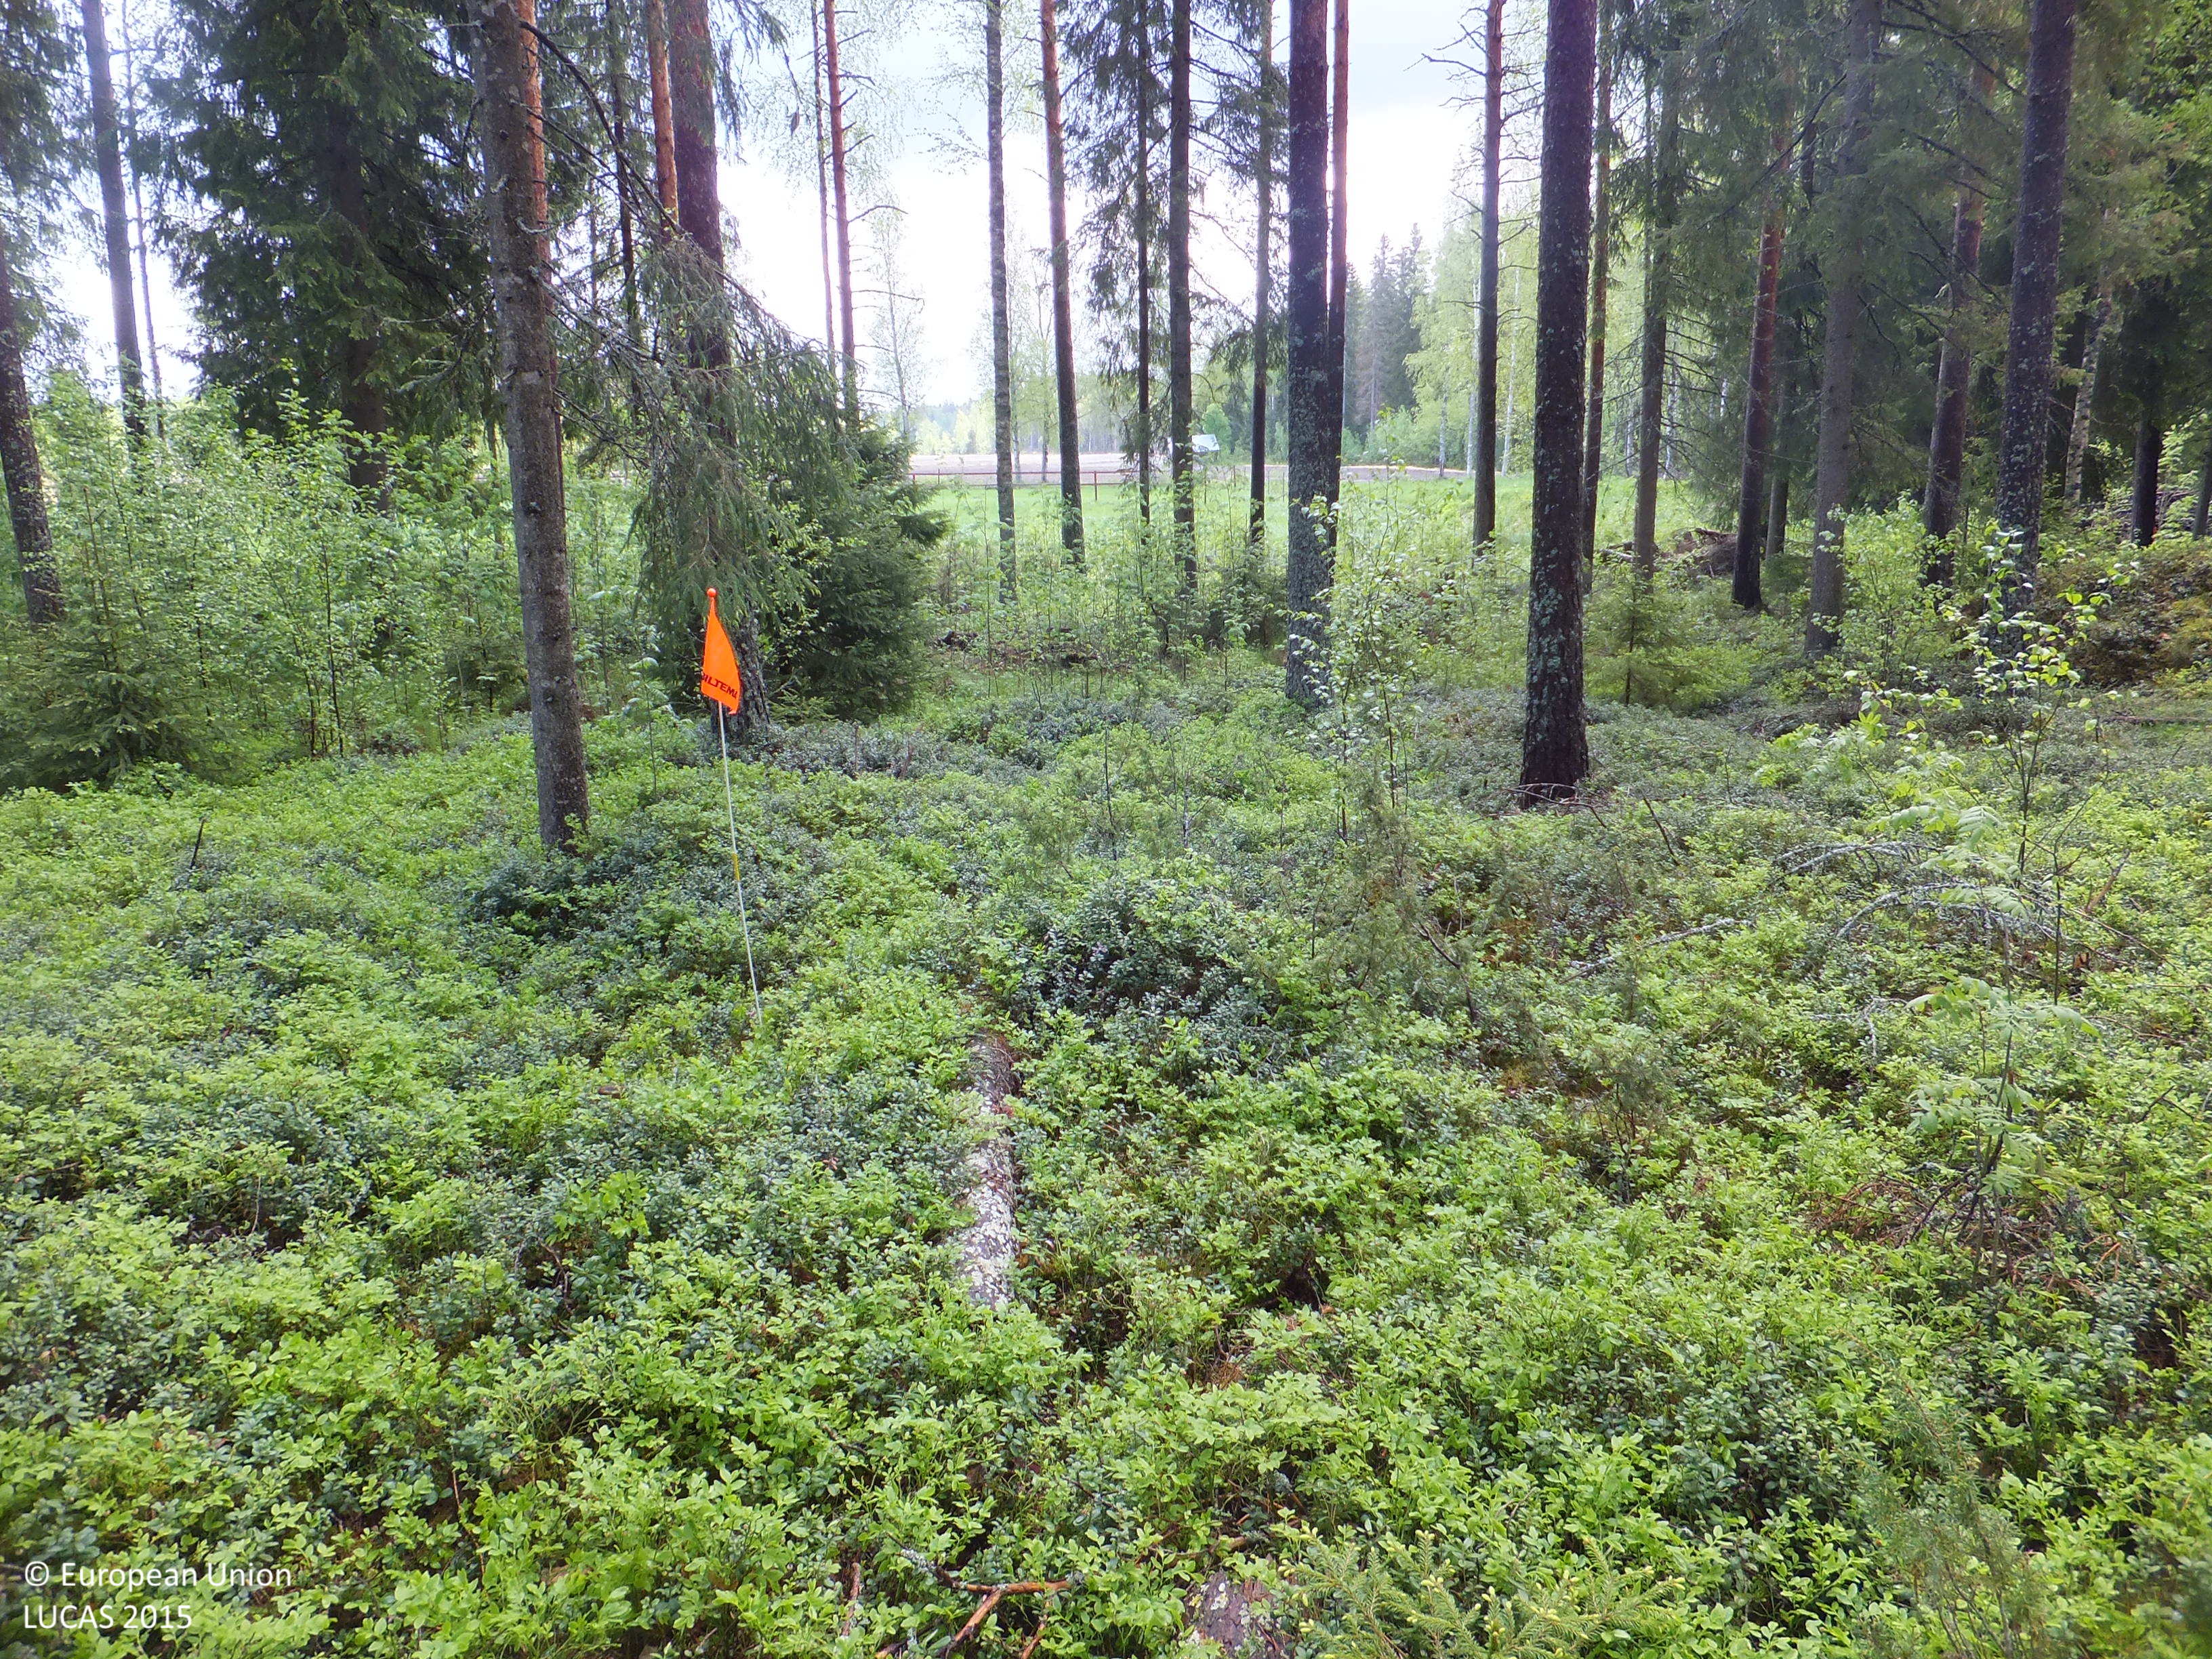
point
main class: Woodland
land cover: Pine dominated coniferous woodland
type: boreal forest
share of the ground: > 75 %
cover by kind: coniferous forest trees 75 %, shrubs 15 %, lichens and mosses 10 %
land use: Forestry
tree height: > 5 m
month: June
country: FI
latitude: 63.5562
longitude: 22.9138
